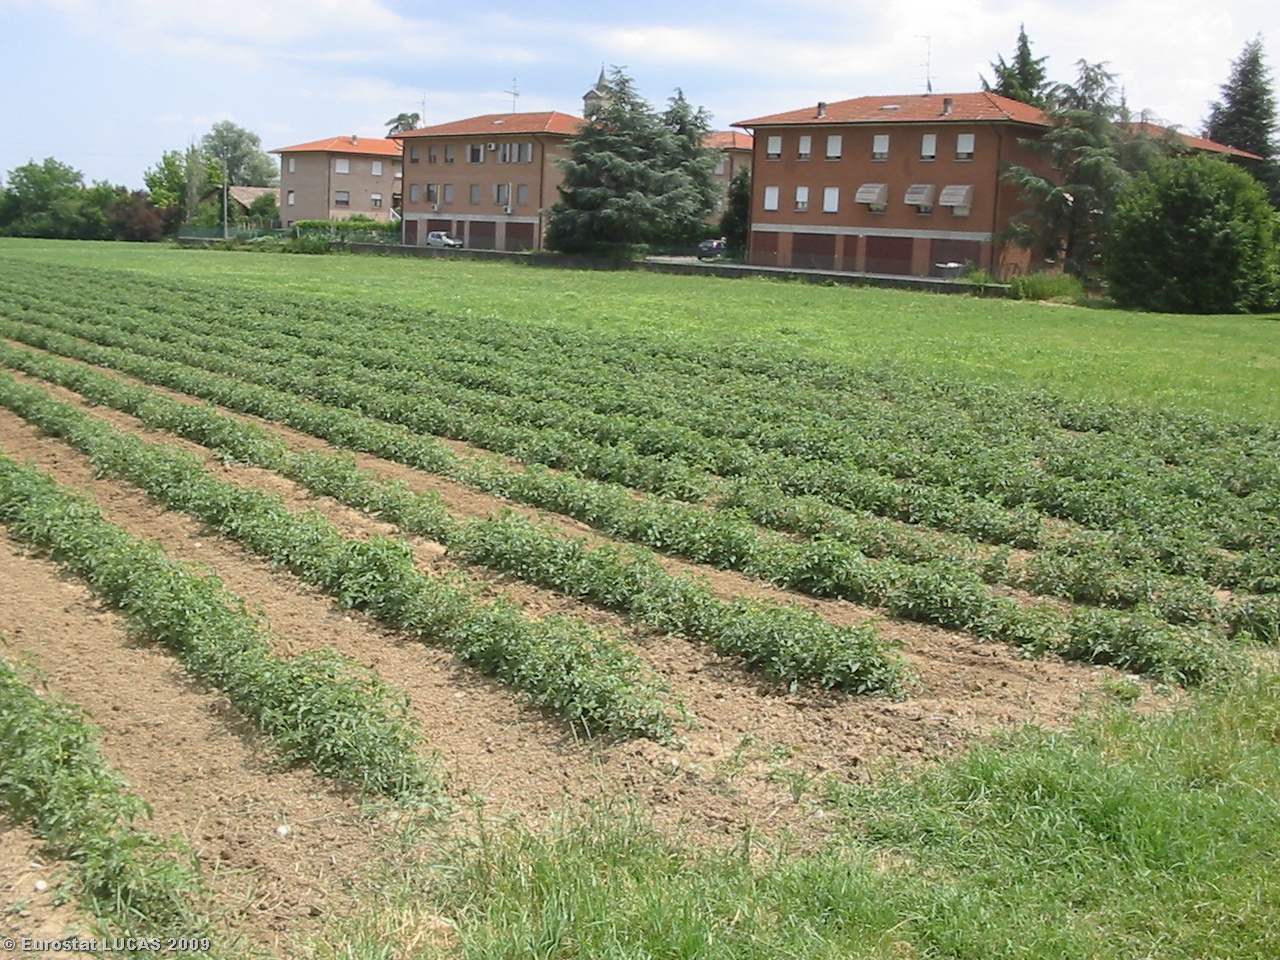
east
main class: Grassland
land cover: Grassland without tree/shrub cover
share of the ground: > 75 %
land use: Agriculture (excluding fallow land and kitchen gardens)
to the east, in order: Grassland without tree/shrub cover; Tomatoes; Grassland without tree/shrub cover; Artificial constructions in urban areas; Paved roads, cycling and walking lanes; Artificial constructions in urban areas; Paved roads, cycling and walking lanes; Managed hedges; Paved roads, cycling and walking lanes; Artificial constructions in urban areas; Managed hedges; Paved roads, cycling and walking lanes; Grassland with sparse tree/shrub cover
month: June
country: IT
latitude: 44.6746
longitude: 10.3399
